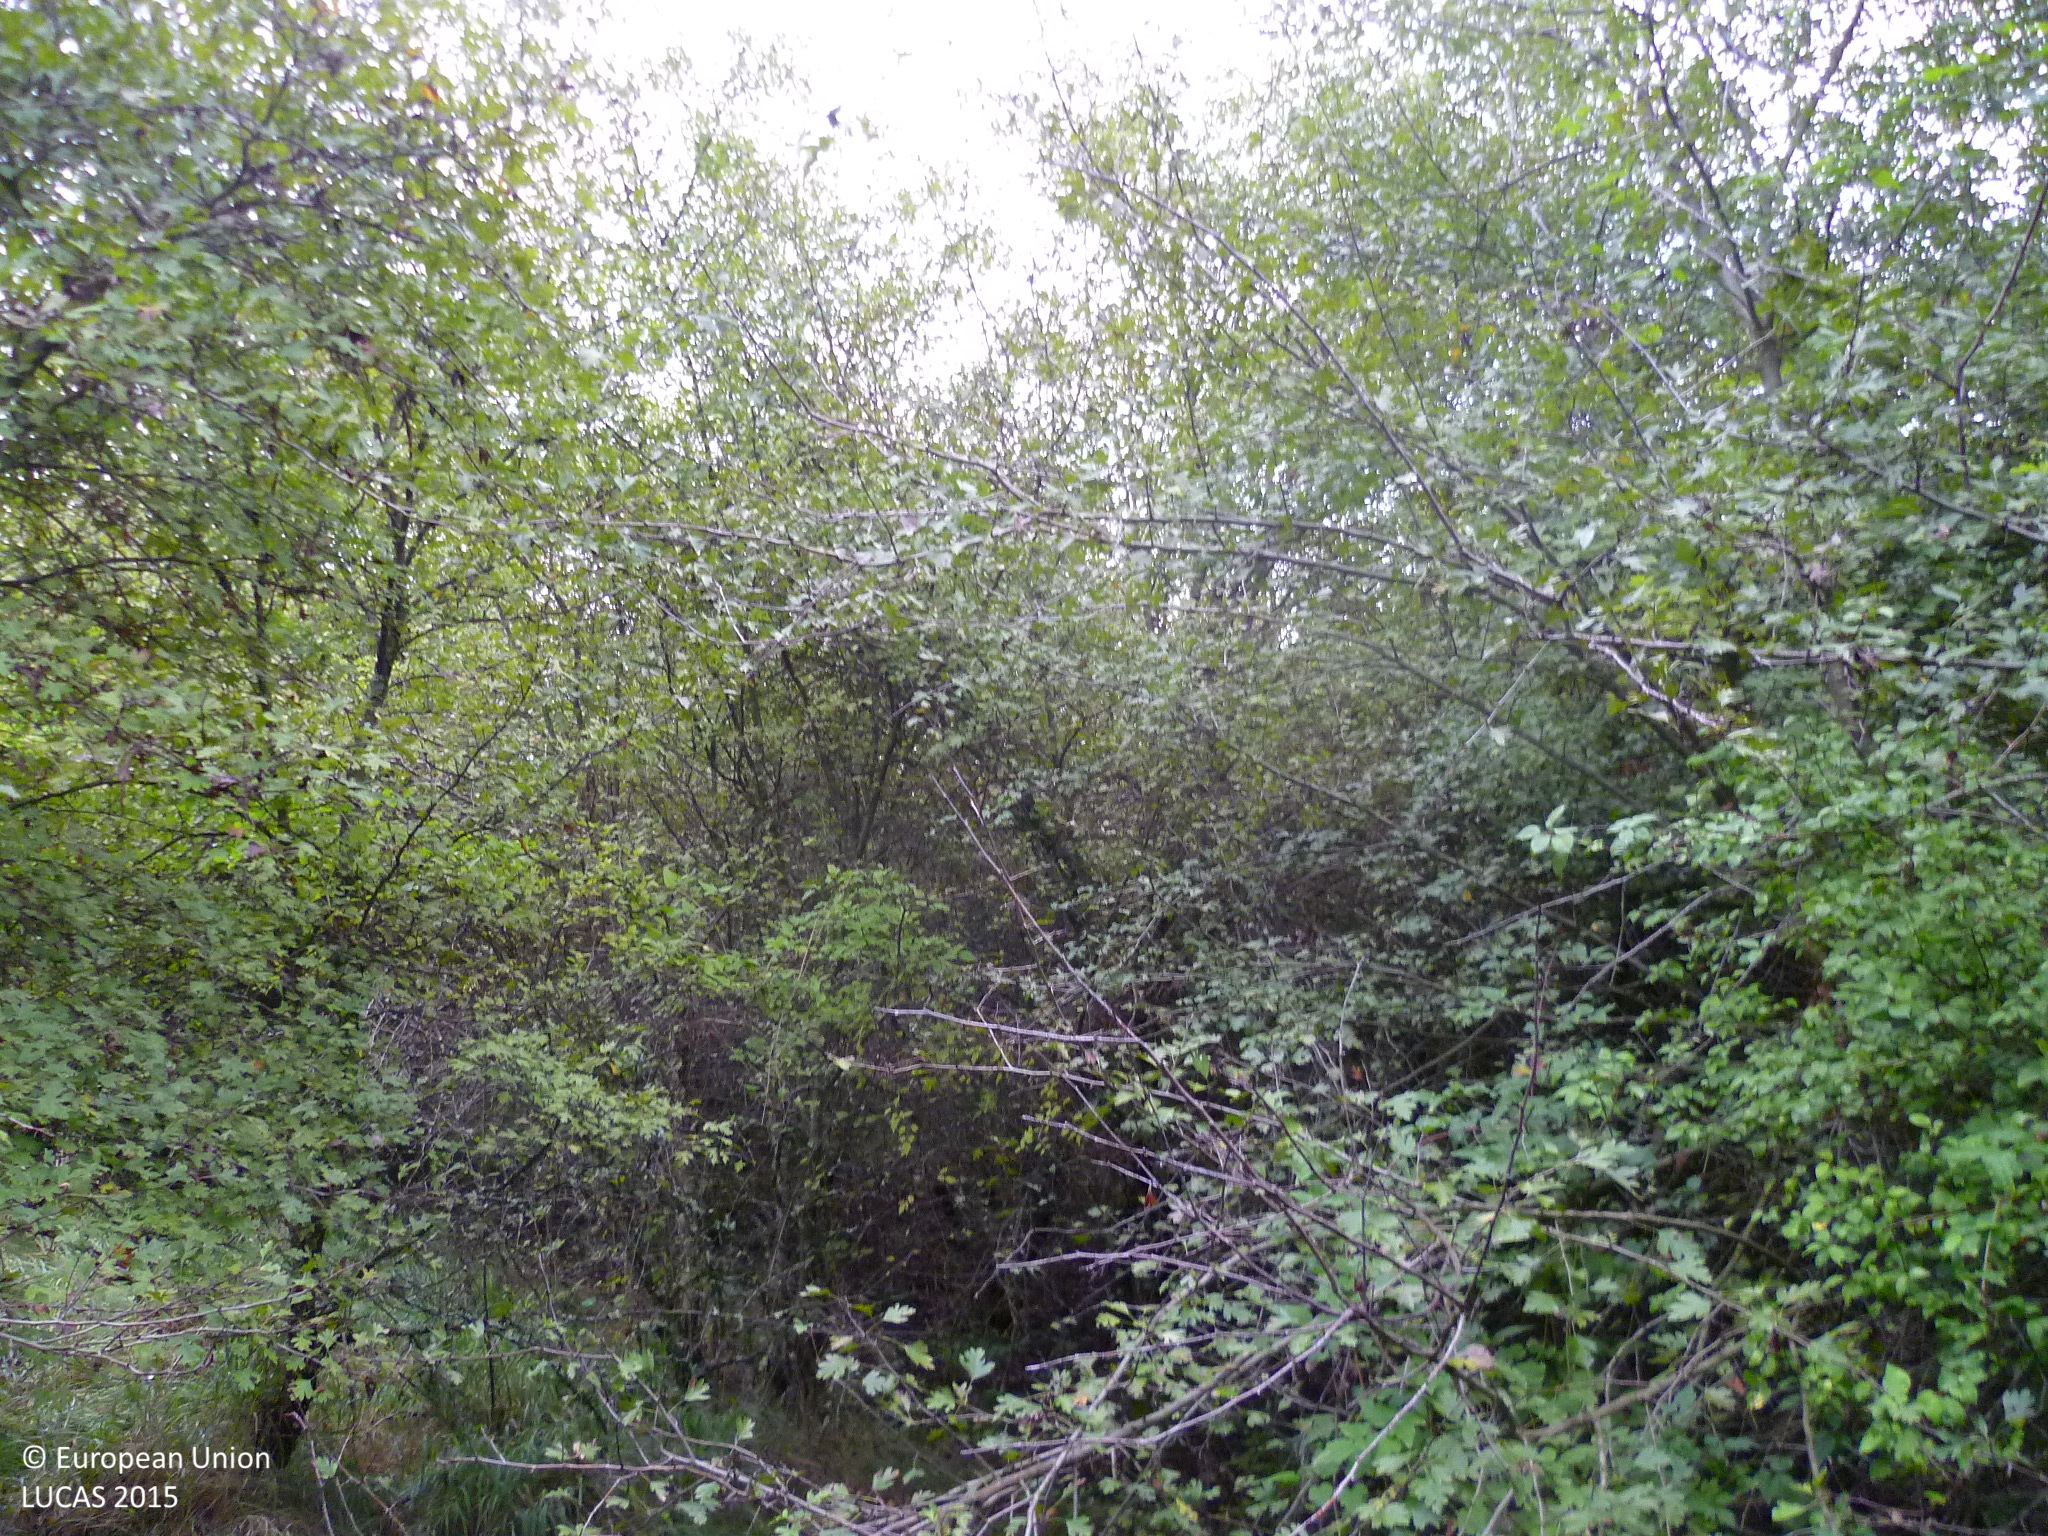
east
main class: Shrubland
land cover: Shrubland with sparse tree cover
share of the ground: > 75 %
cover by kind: shrubs 90 %, broadleaved forest trees 5 %, herbaceous plants 5 %
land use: Semi-natural and natural areas not in use
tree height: < 5 m
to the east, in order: Shrubland with sparse tree cover; Broadleaved woodland; Grass margins; Tracks; Grass margins; Rye
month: September
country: BG
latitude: 42.7488
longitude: 22.8191
